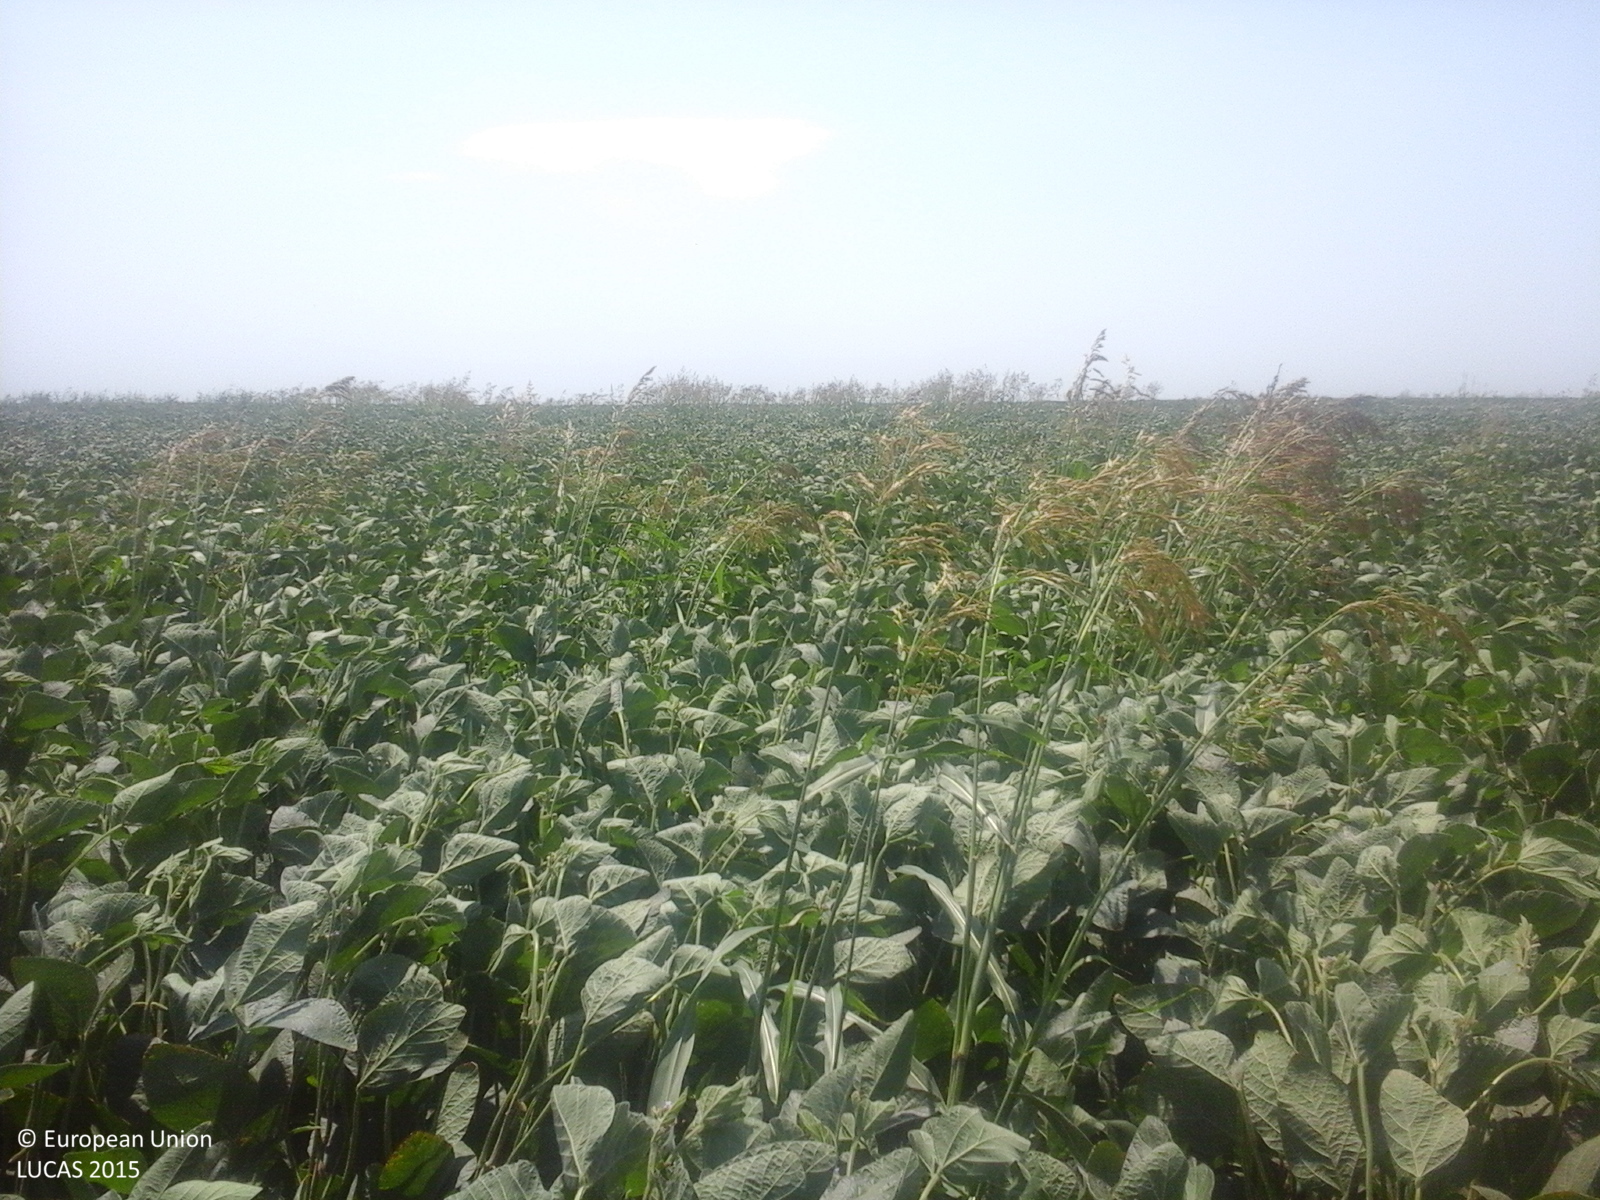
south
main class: Cropland
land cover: Soya
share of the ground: > 75 %
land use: Agriculture (excluding fallow land and kitchen gardens)
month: August
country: RO
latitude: 45.1551
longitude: 27.6971
